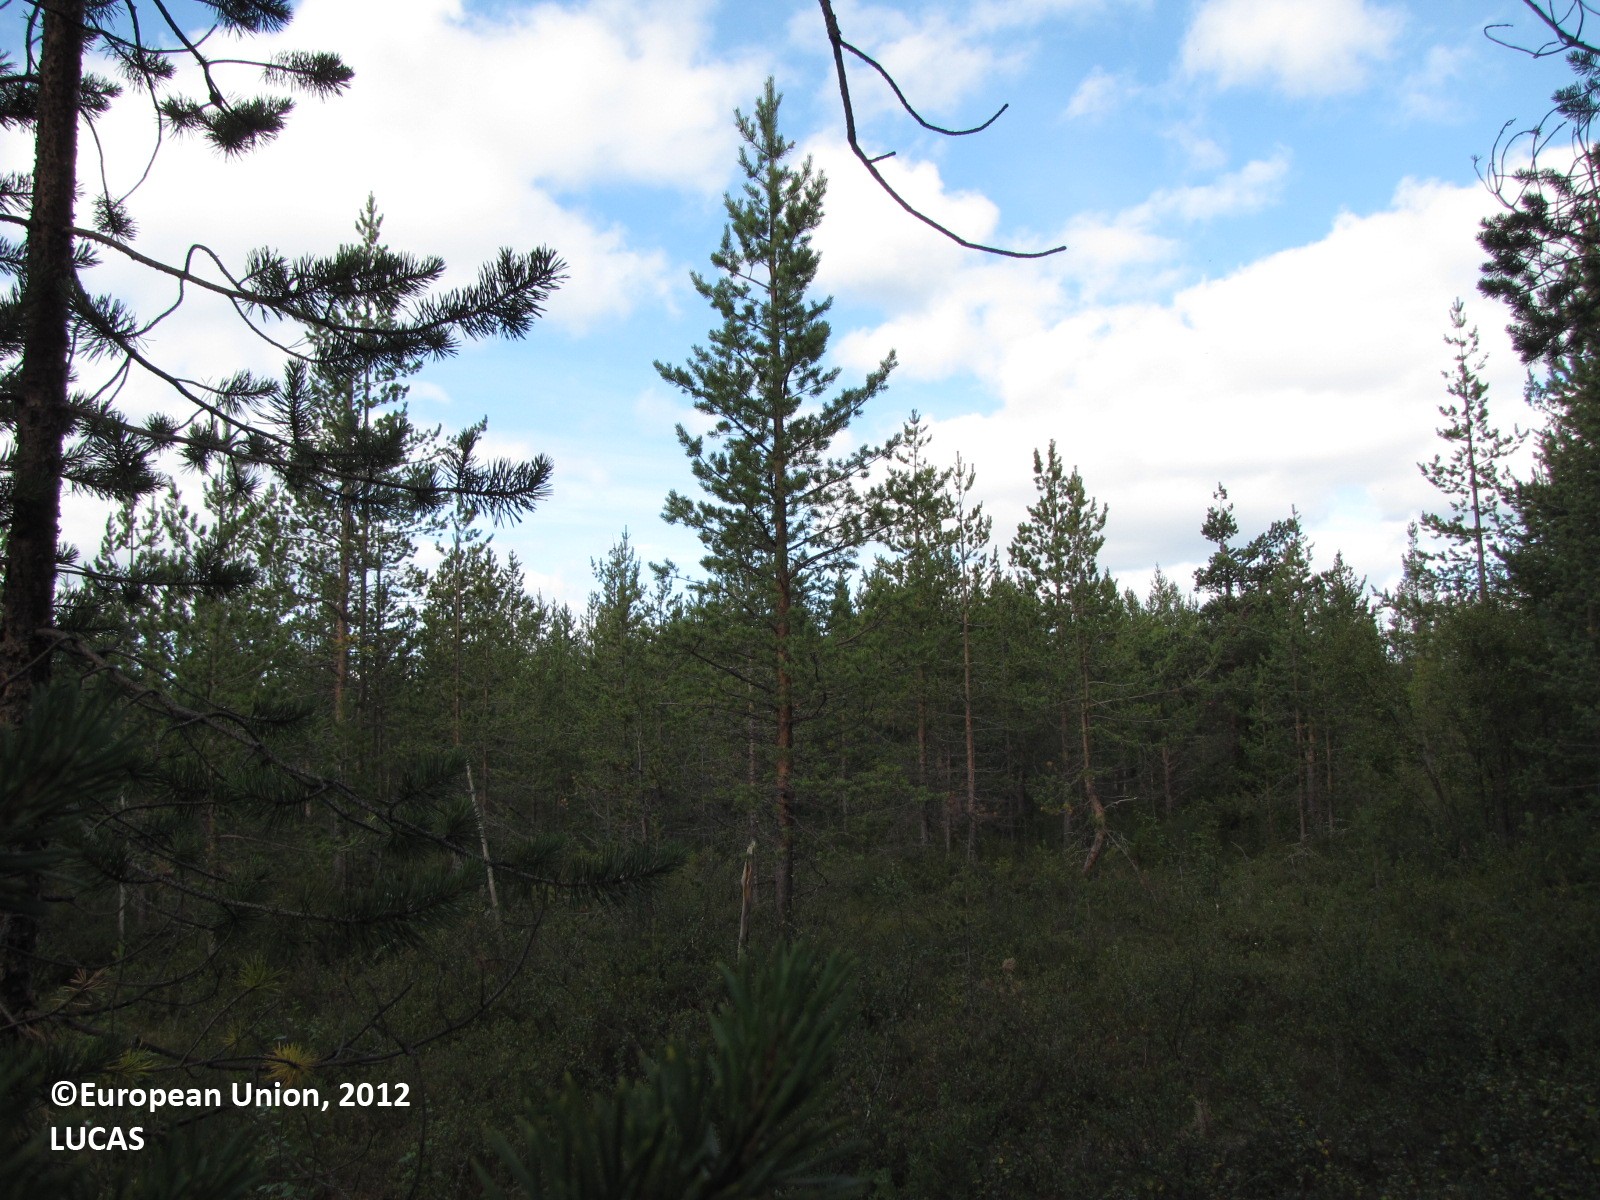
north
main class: Woodland
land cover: Pine dominated coniferous woodland
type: boreal forest
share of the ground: 50 - 75 %
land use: Forestry
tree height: > 5 m
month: August
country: FI
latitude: 66.8490
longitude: 25.1175
